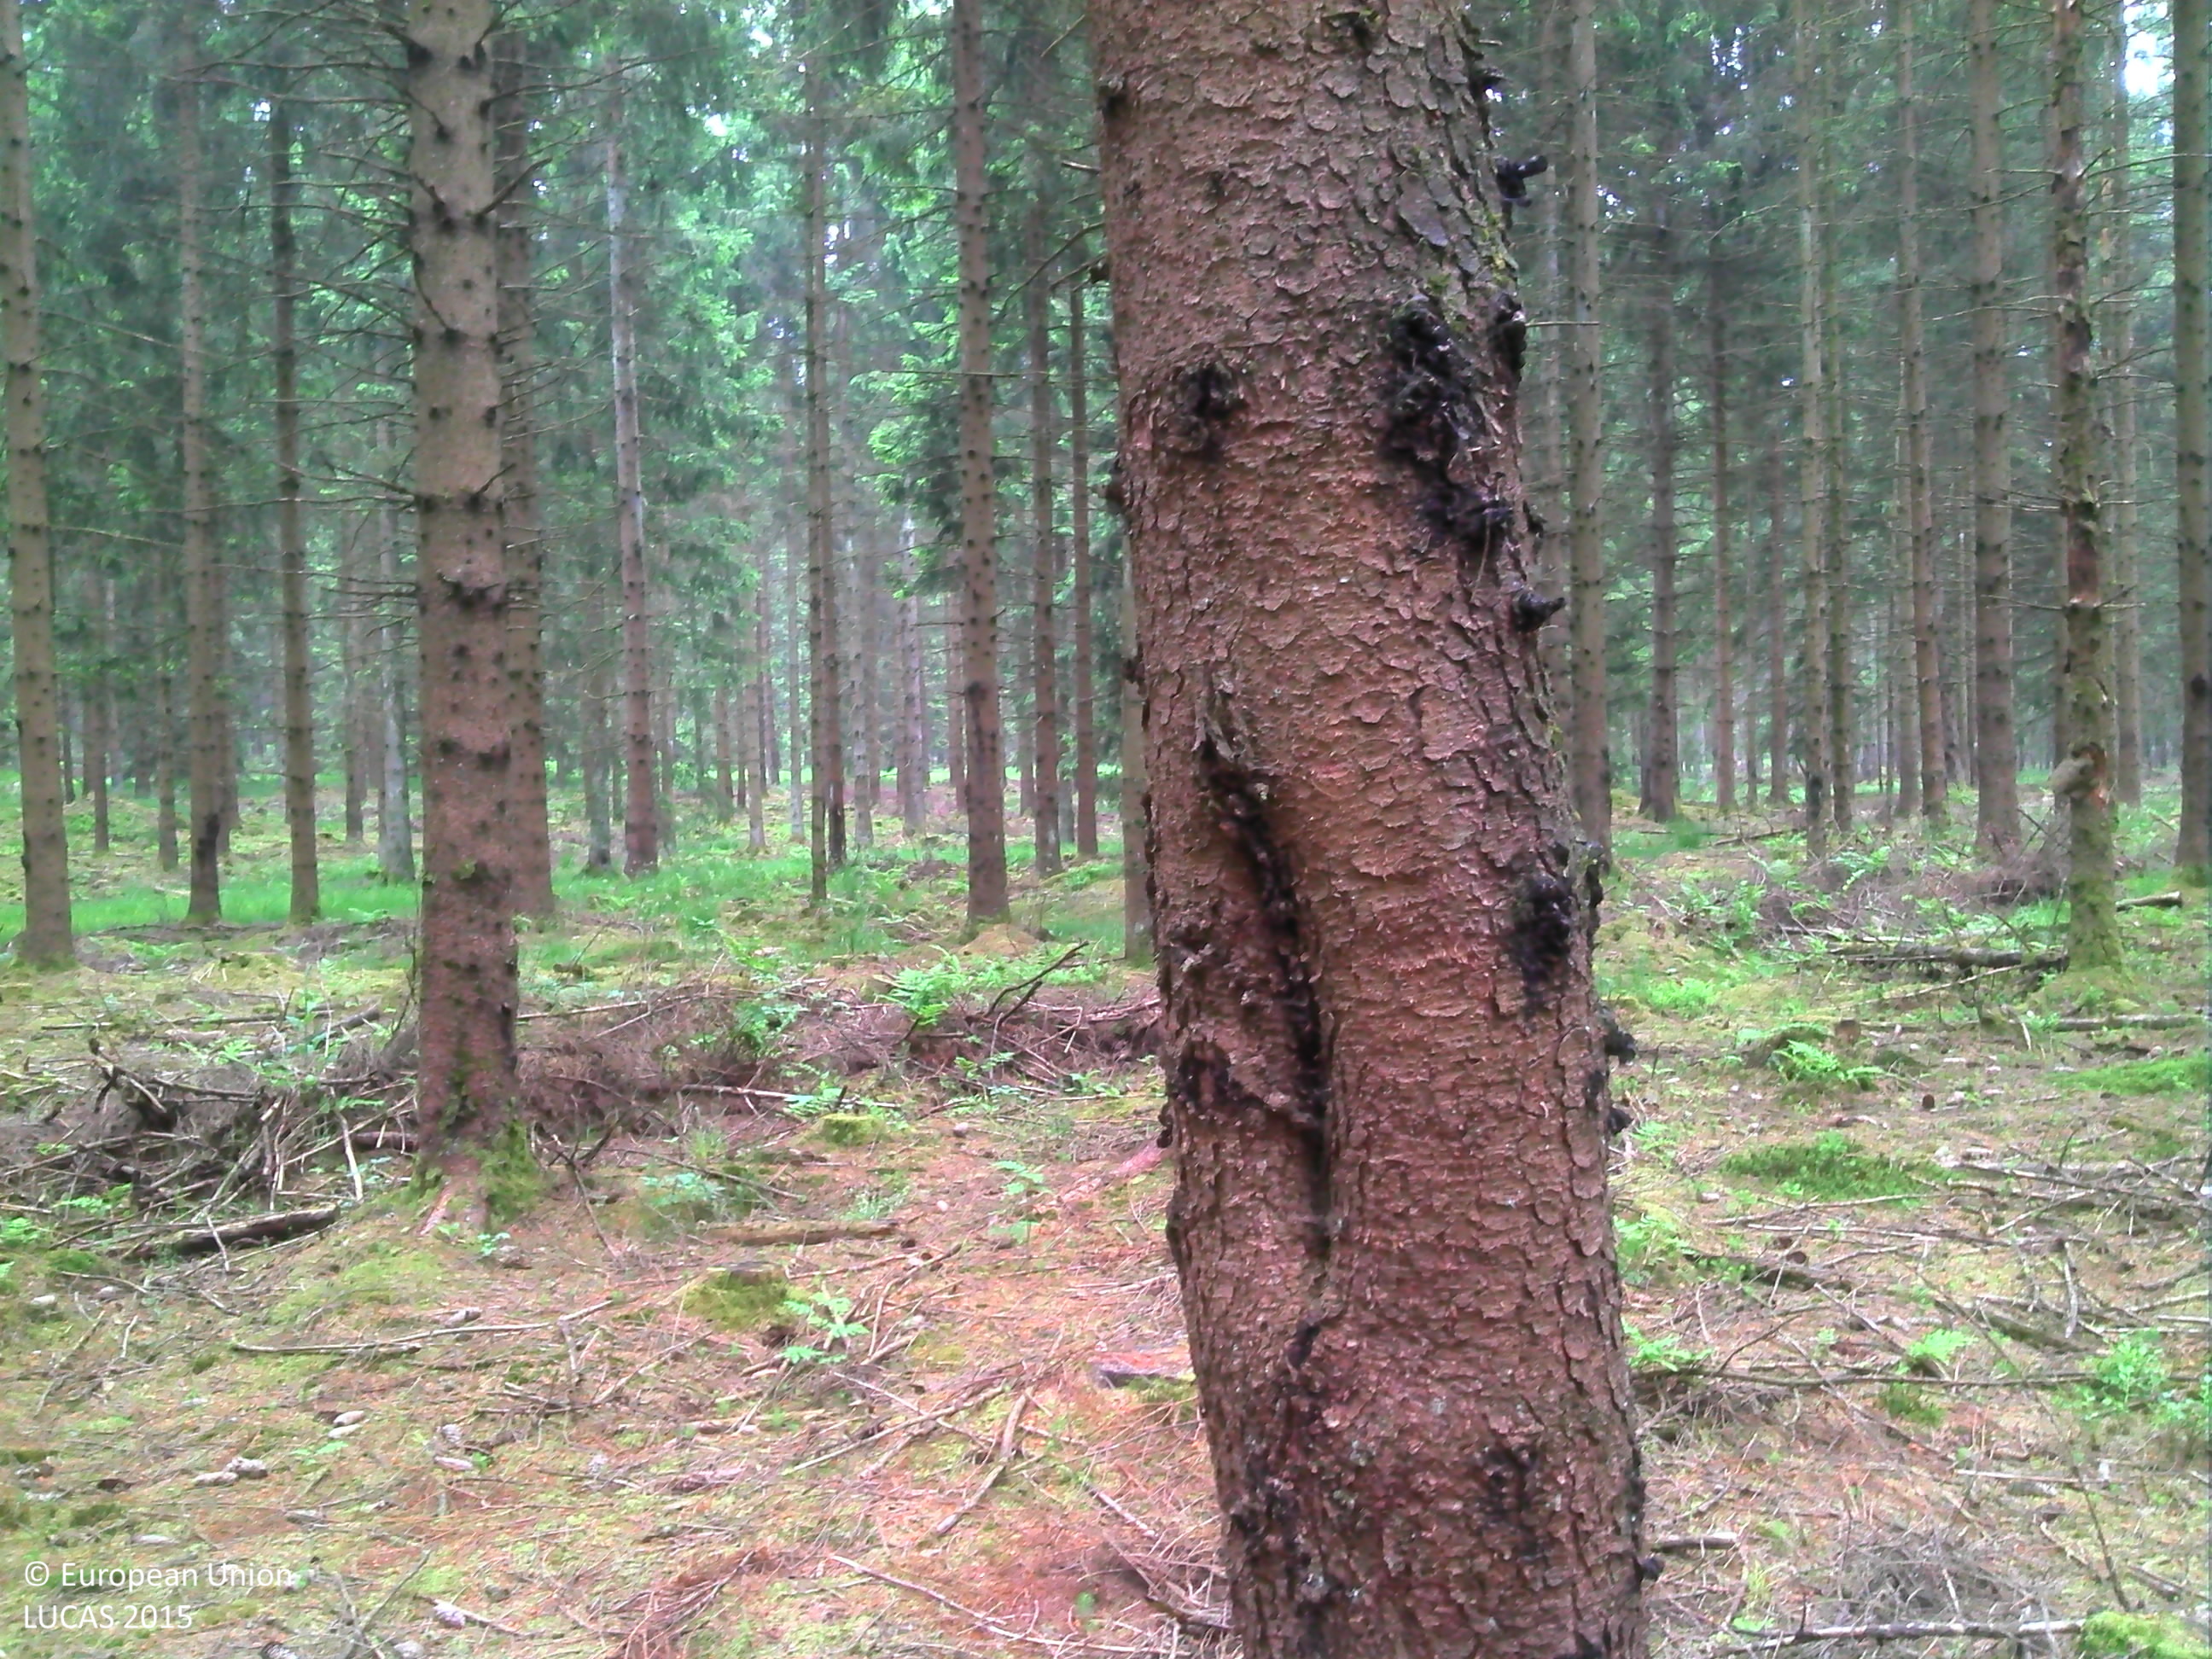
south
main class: Woodland
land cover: Spruce dominated coniferous woodland
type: exotic forest
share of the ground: > 75 %
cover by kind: coniferous forest trees 95 %, herbaceous plants 5 %
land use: Forestry
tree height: > 5 m
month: June
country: BE
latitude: 50.4661
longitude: 6.2942
